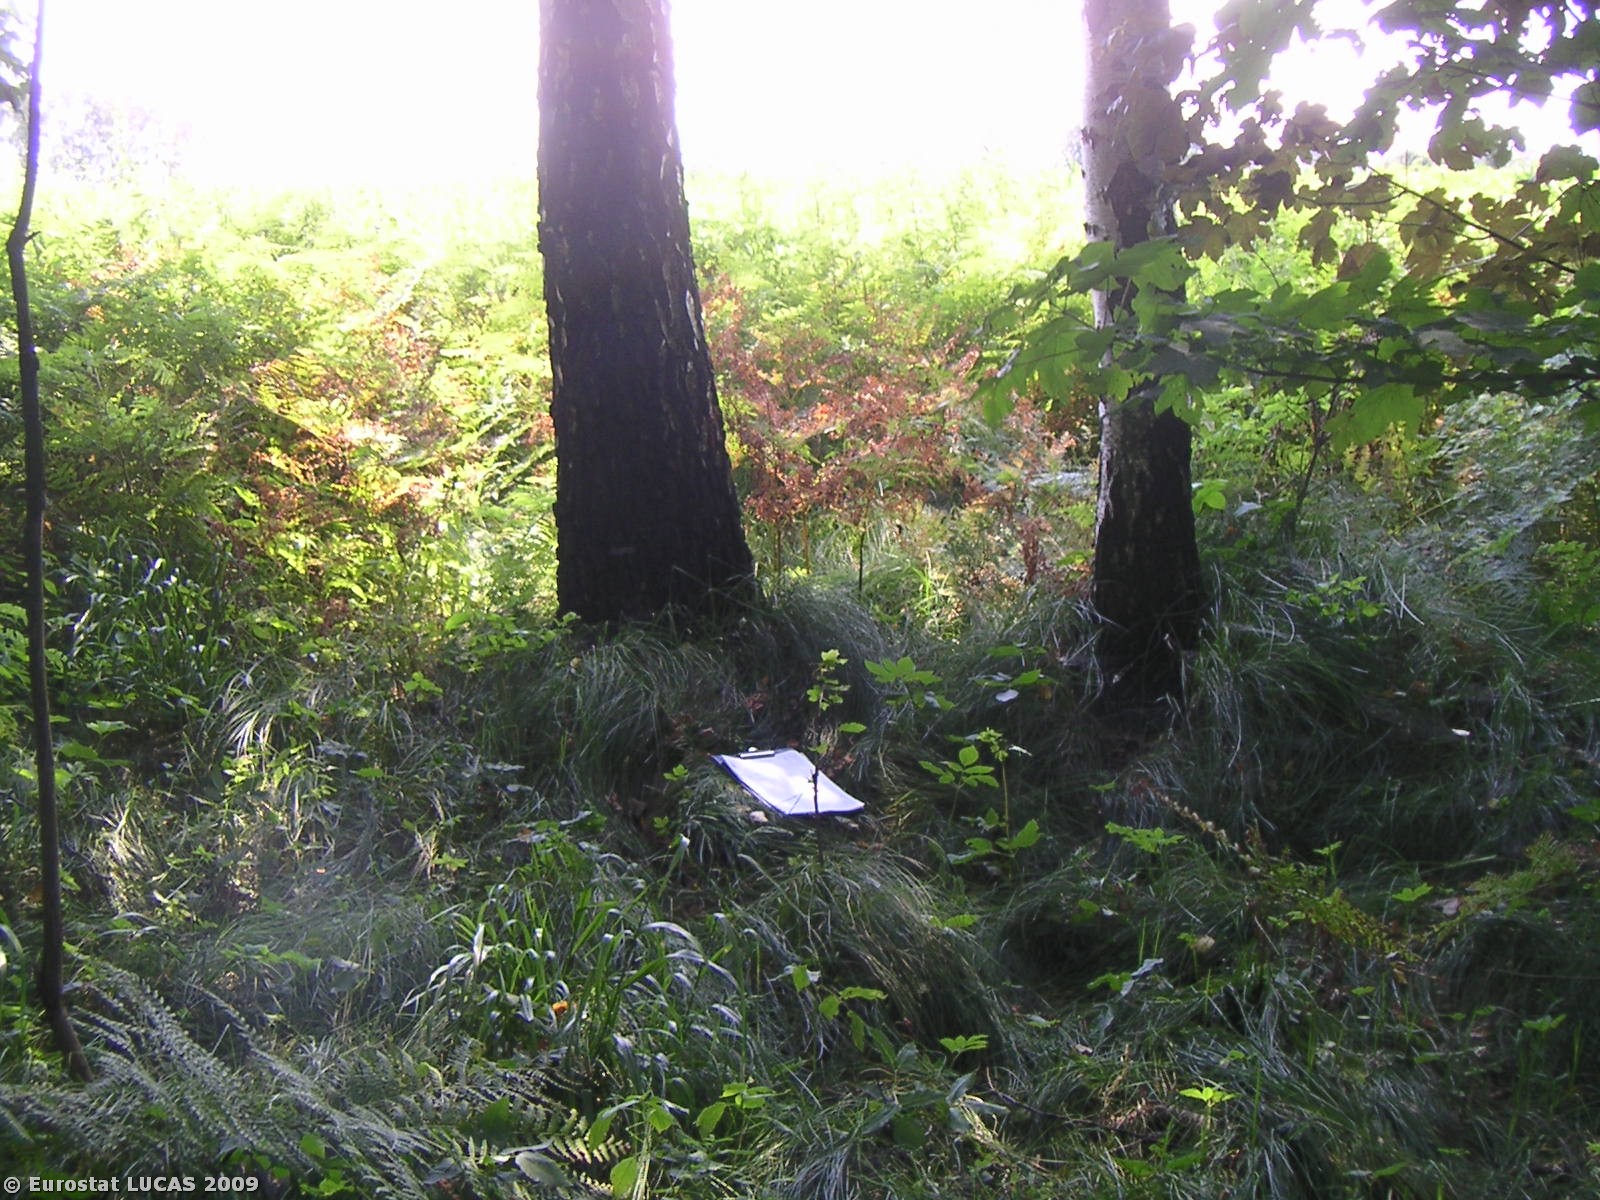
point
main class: Woodland
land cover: Mixed woodland
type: hemiboreal forest and nemoral coniferous forest and mixed broadleaved-coniferous forest
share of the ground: > 75 %
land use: Forestry
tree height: > 5 m
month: July
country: PL
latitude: 50.0108
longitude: 18.7421
